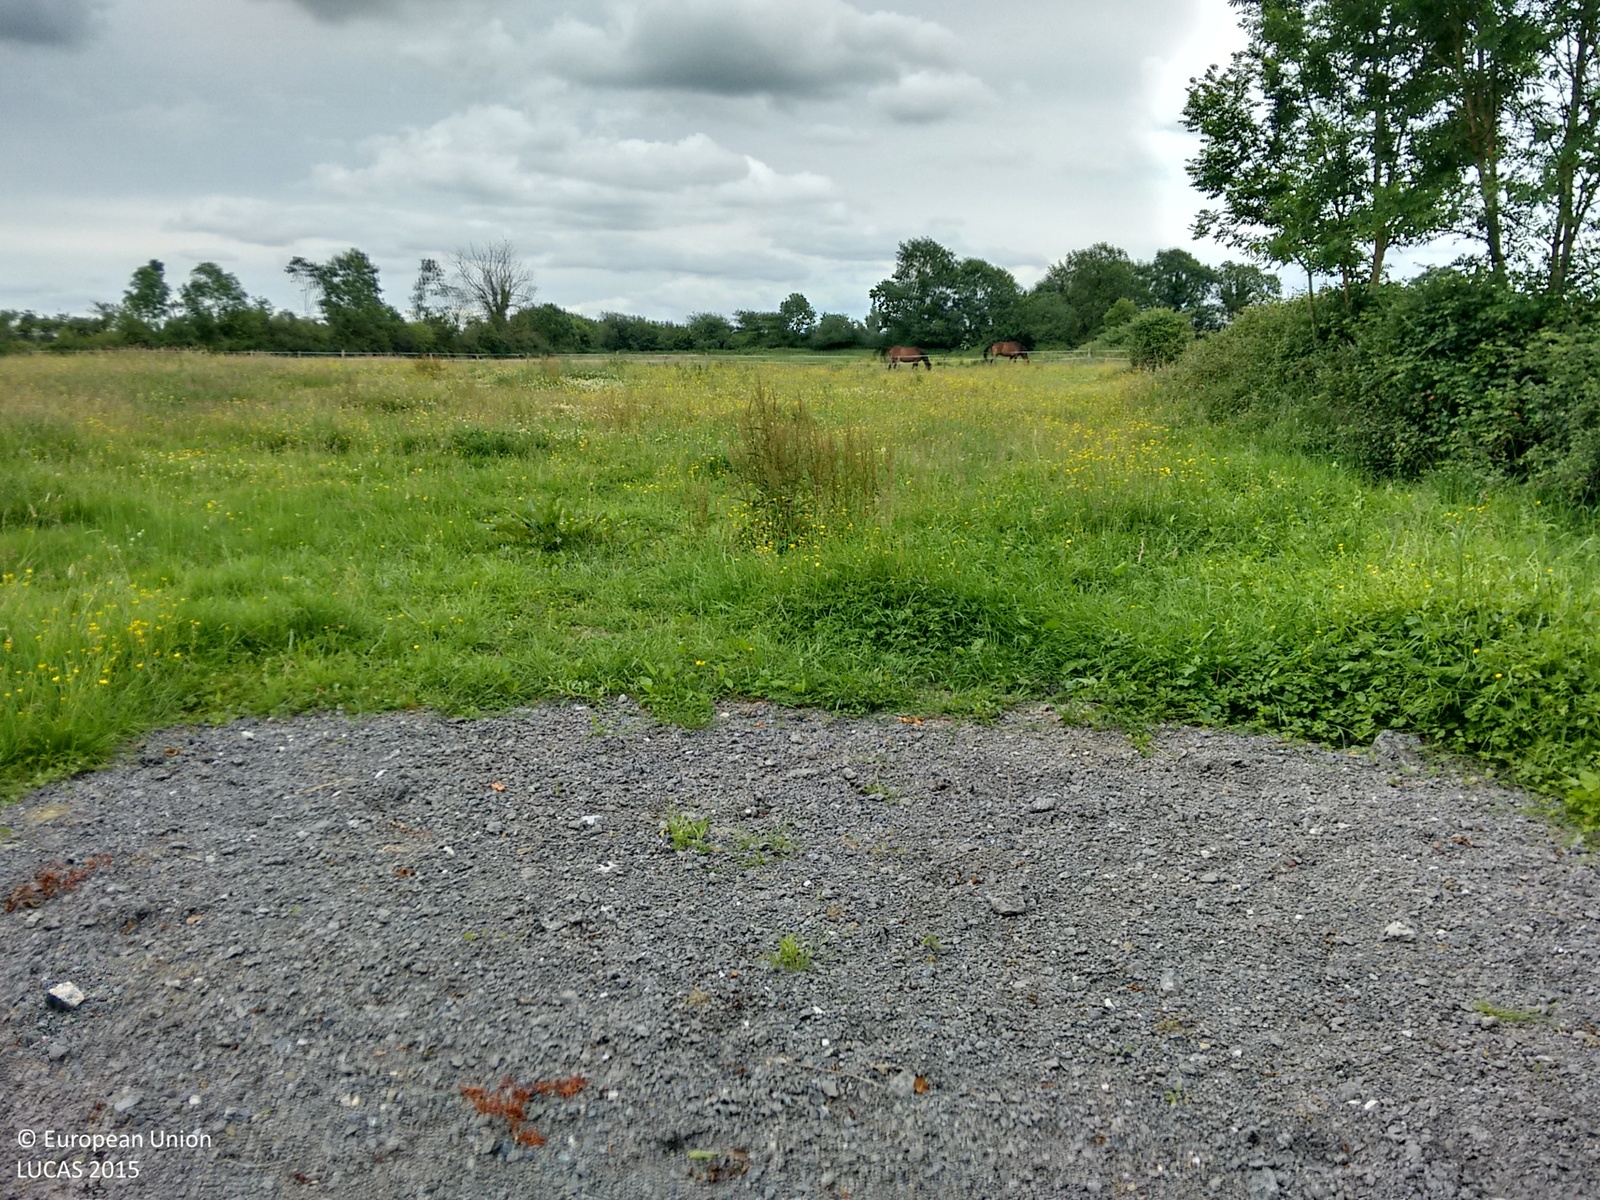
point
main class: Grassland
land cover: Grassland without tree/shrub cover
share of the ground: > 75 %
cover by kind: herbaceous plants 100 %
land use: Agriculture (excluding fallow land and kitchen gardens)
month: July
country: IE
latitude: 52.5650
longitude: -7.4320
